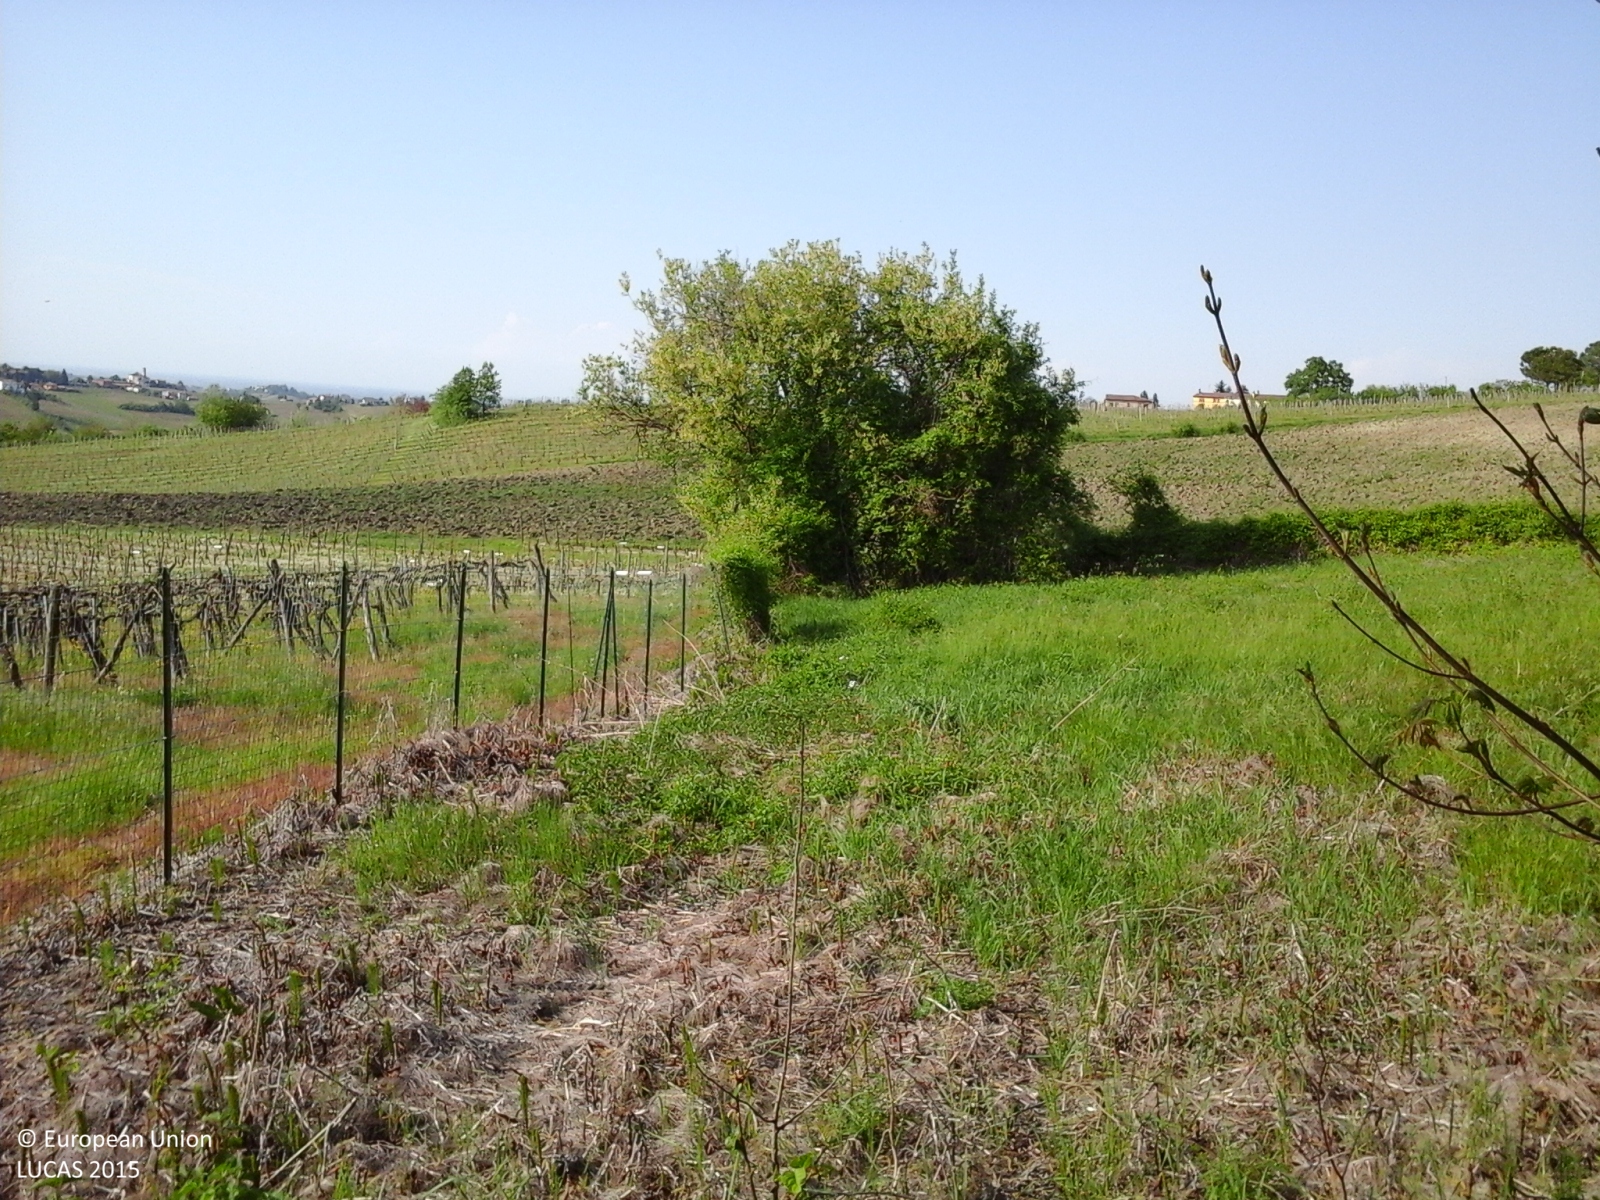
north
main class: Woodland
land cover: Broadleaved woodland
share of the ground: > 75 %
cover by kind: herbaceous plants 70 %, broadleaved forest trees 30 %
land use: Semi-natural and natural areas not in use
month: April
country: IT
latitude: 44.9979
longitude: 9.3796
